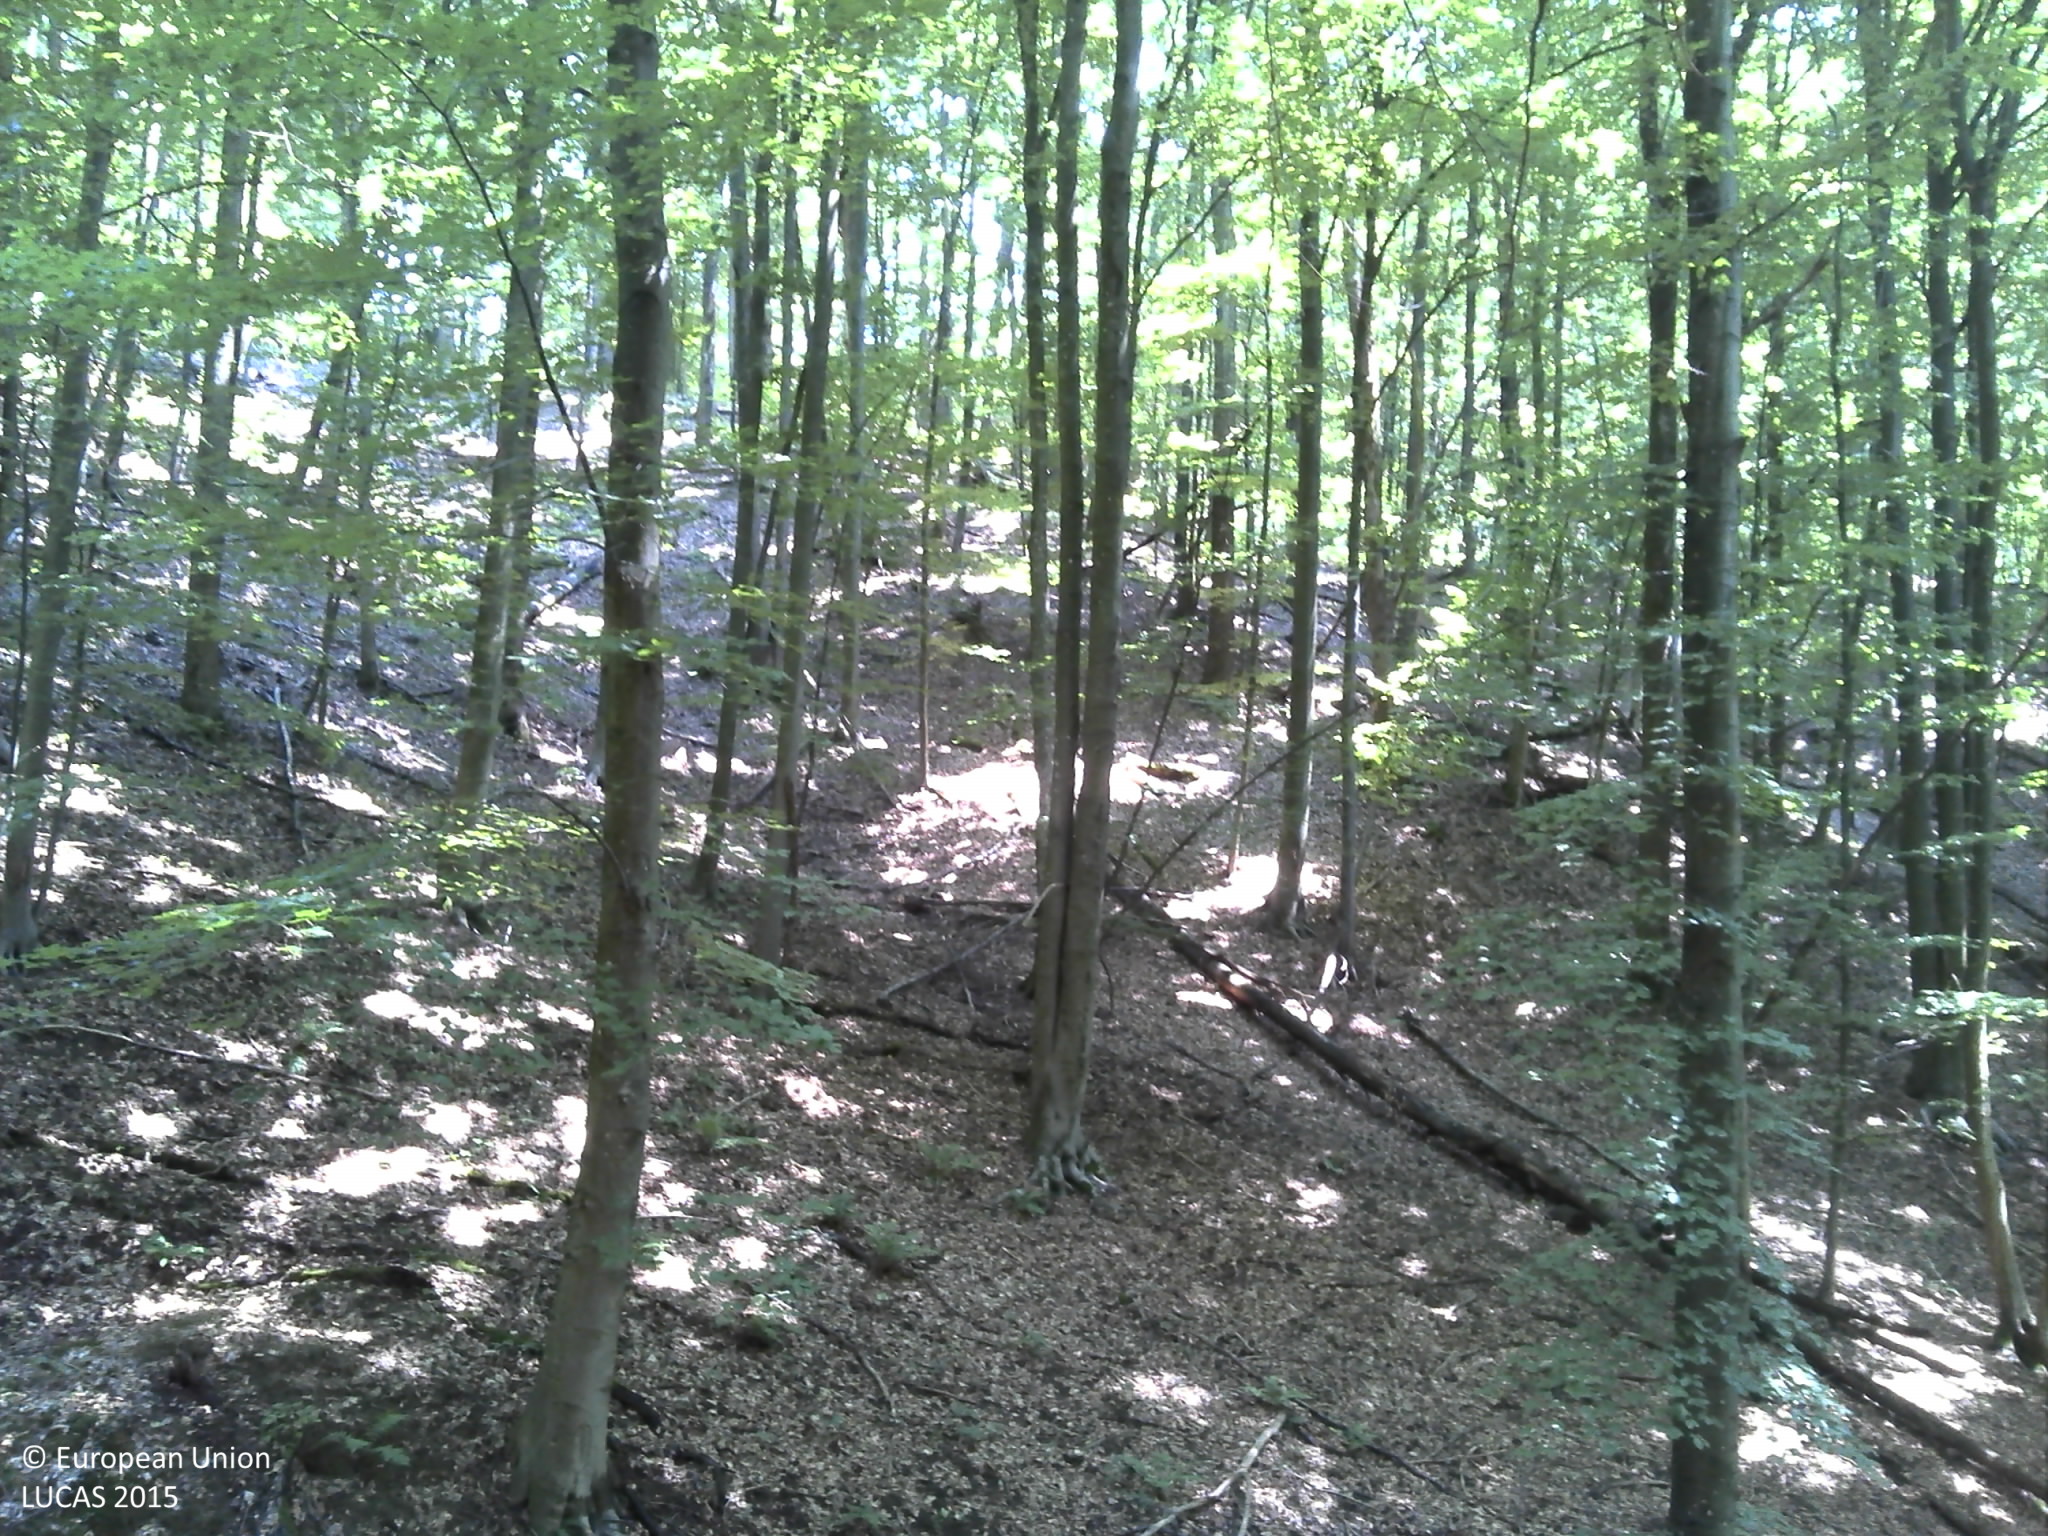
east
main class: Woodland
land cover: Broadleaved woodland
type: beech forest
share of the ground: > 75 %
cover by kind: broadleaved forest trees 80 %, lichens and mosses 20 %
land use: Forestry
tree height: > 5 m
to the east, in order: Broadleaved woodland
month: July
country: HR
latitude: 45.6149
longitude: 16.7317
